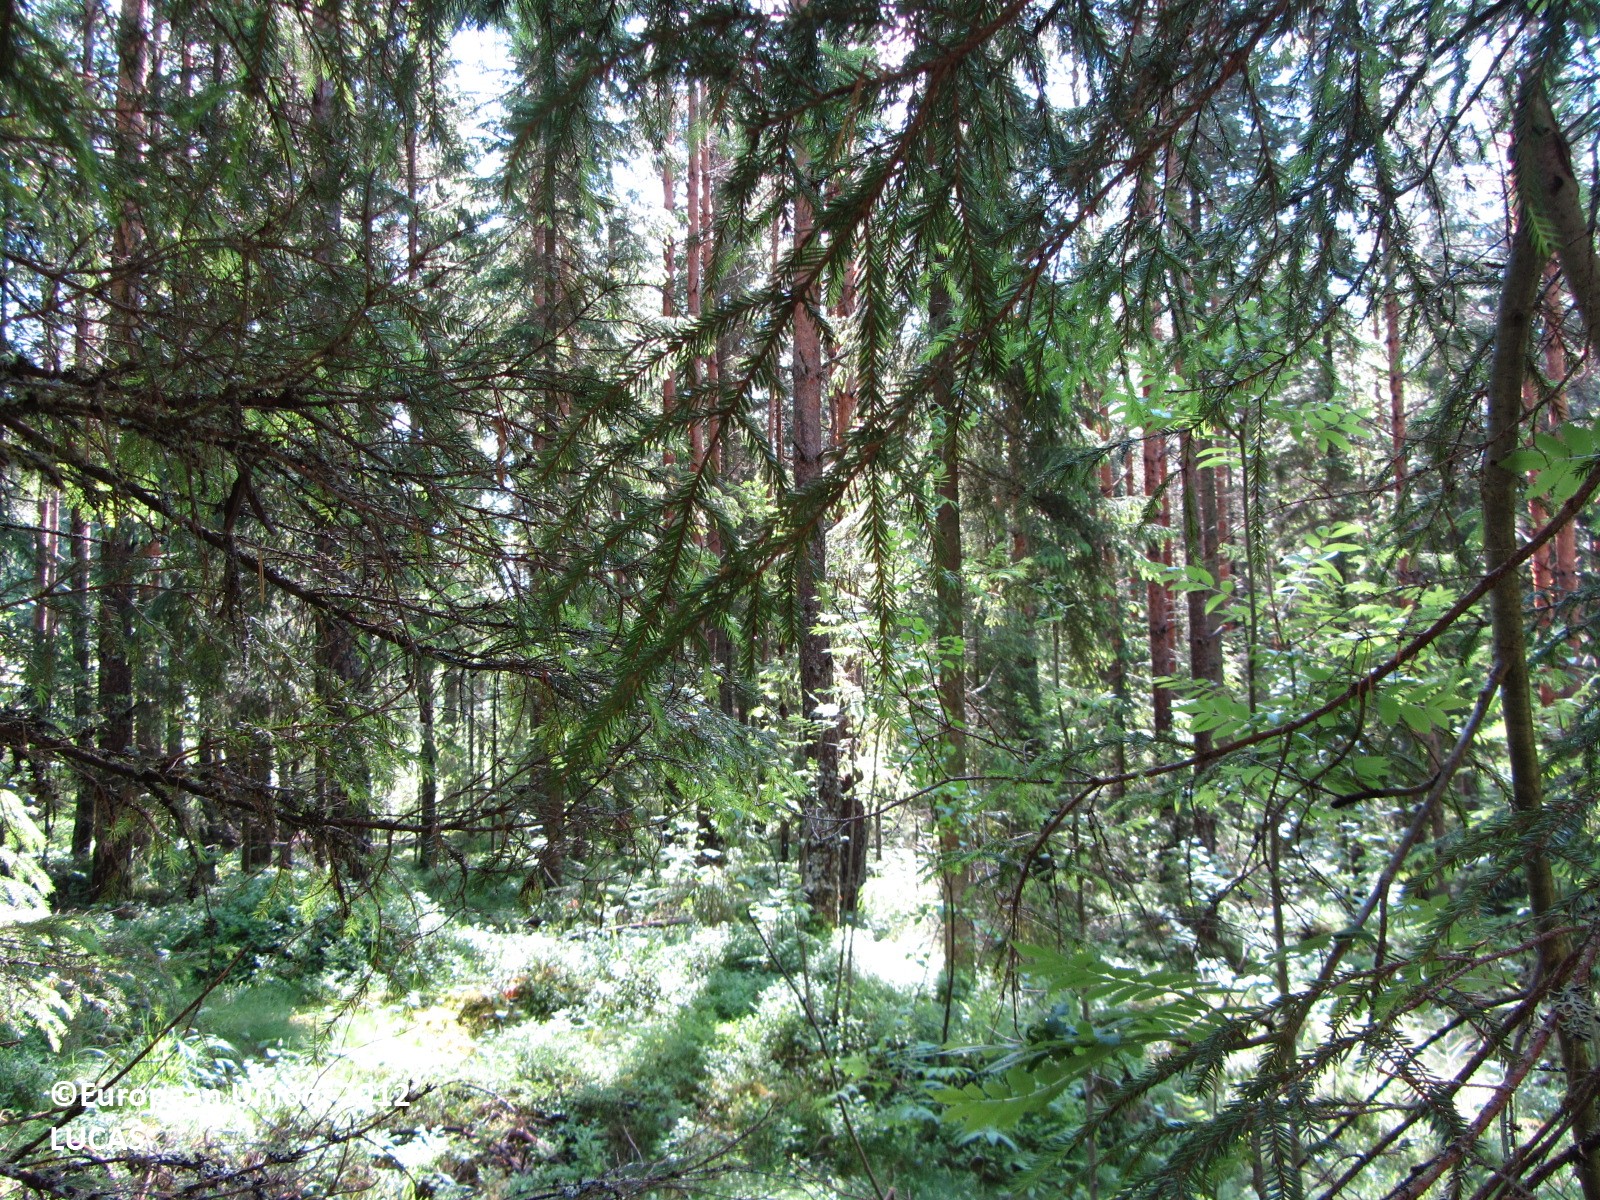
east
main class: Woodland
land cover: Other coniferous woodland
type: boreal forest
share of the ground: 50 - 75 %
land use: Forestry
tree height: > 5 m
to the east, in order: Other coniferous woodland; Pine dominated mixed woodland; Spruce dominated mixed woodland; Grassland with sparse tree/shrub cover; Broadleaved woodland; Shrubland with sparse tree cover; Spruce dominated coniferous woodland; Spruce dominated mixed woodland; Grassland with sparse tree/shrub cover; Artificial constructions in urban areas; Spontaneously vegetated surfaces; Paved roads, cycling and walking lanes; Spontaneously vegetated surfaces; Broadleaved woodland
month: June
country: FI
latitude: 62.1211
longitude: 25.2735
